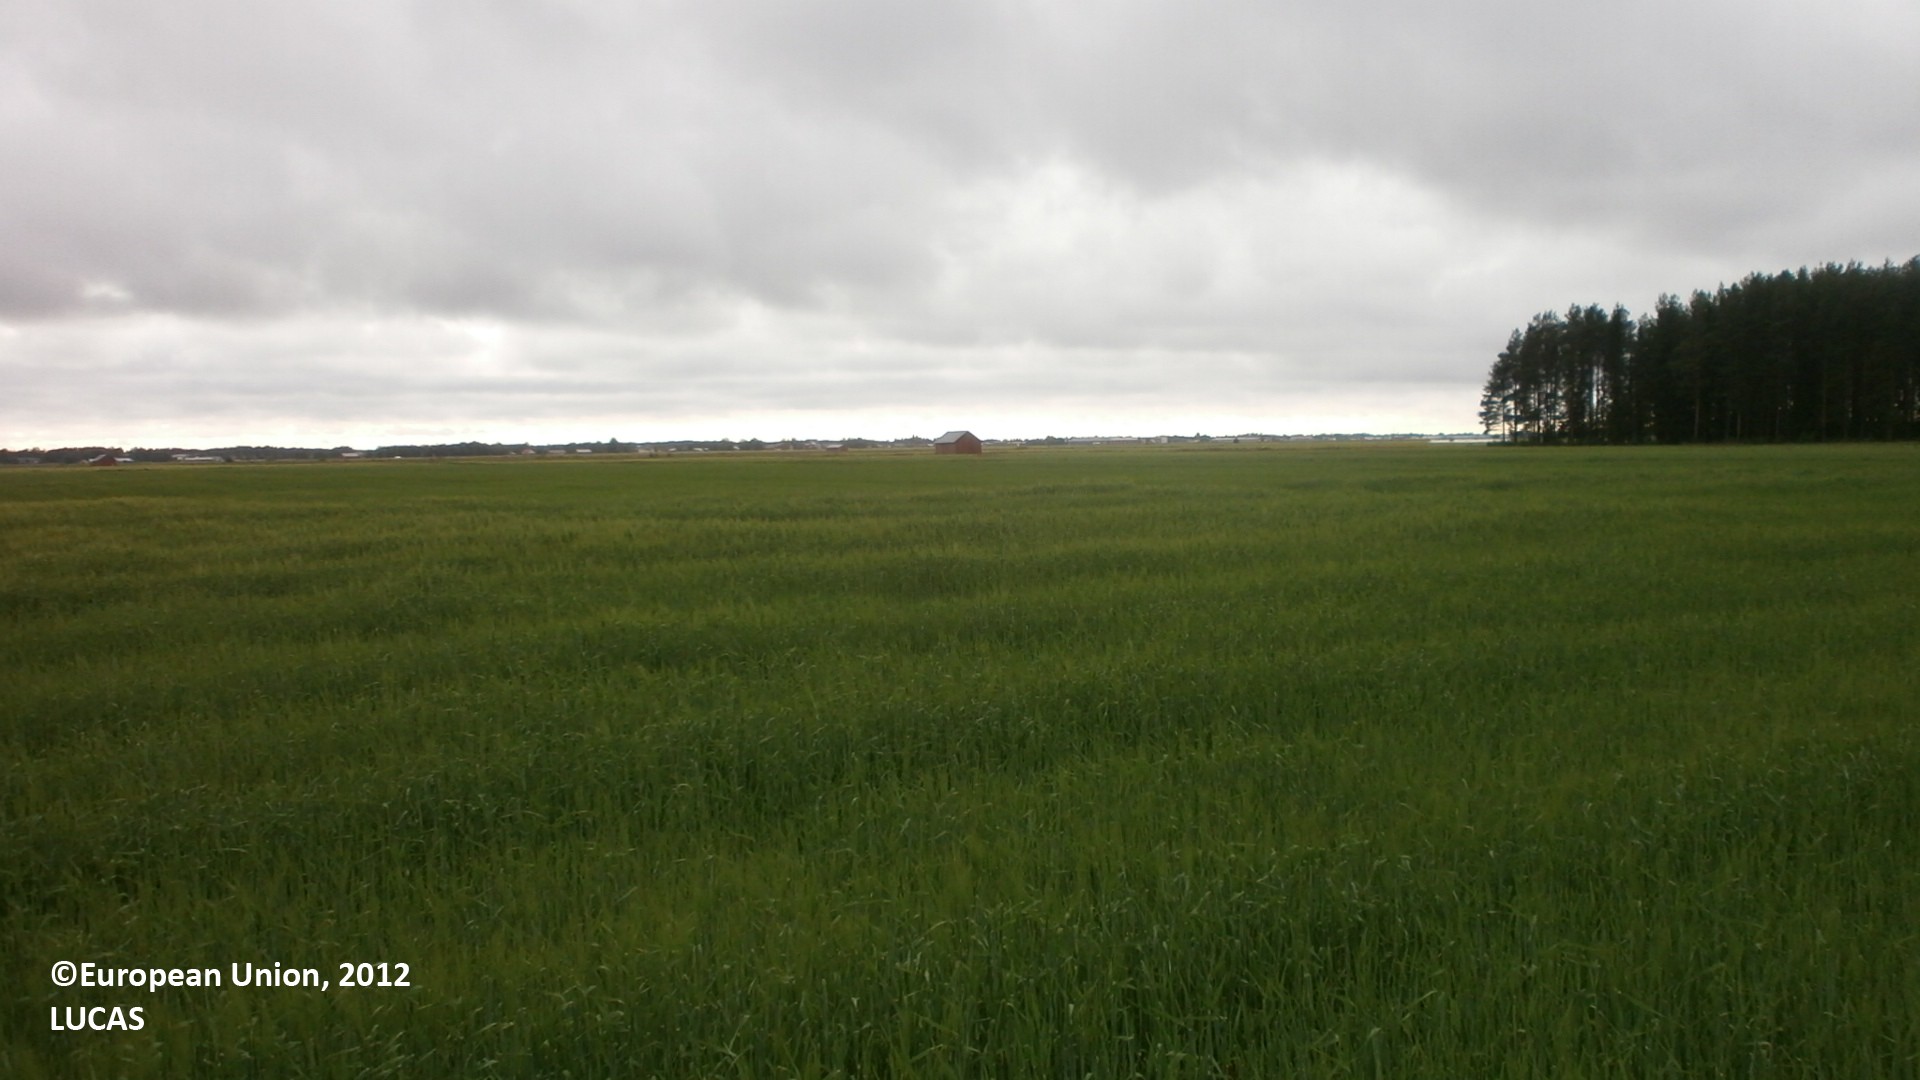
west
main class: Cropland
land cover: Barley
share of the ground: > 75 %
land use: Agriculture (excluding fallow land and kitchen gardens)
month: July
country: FI
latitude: 64.2282
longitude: 24.0610
